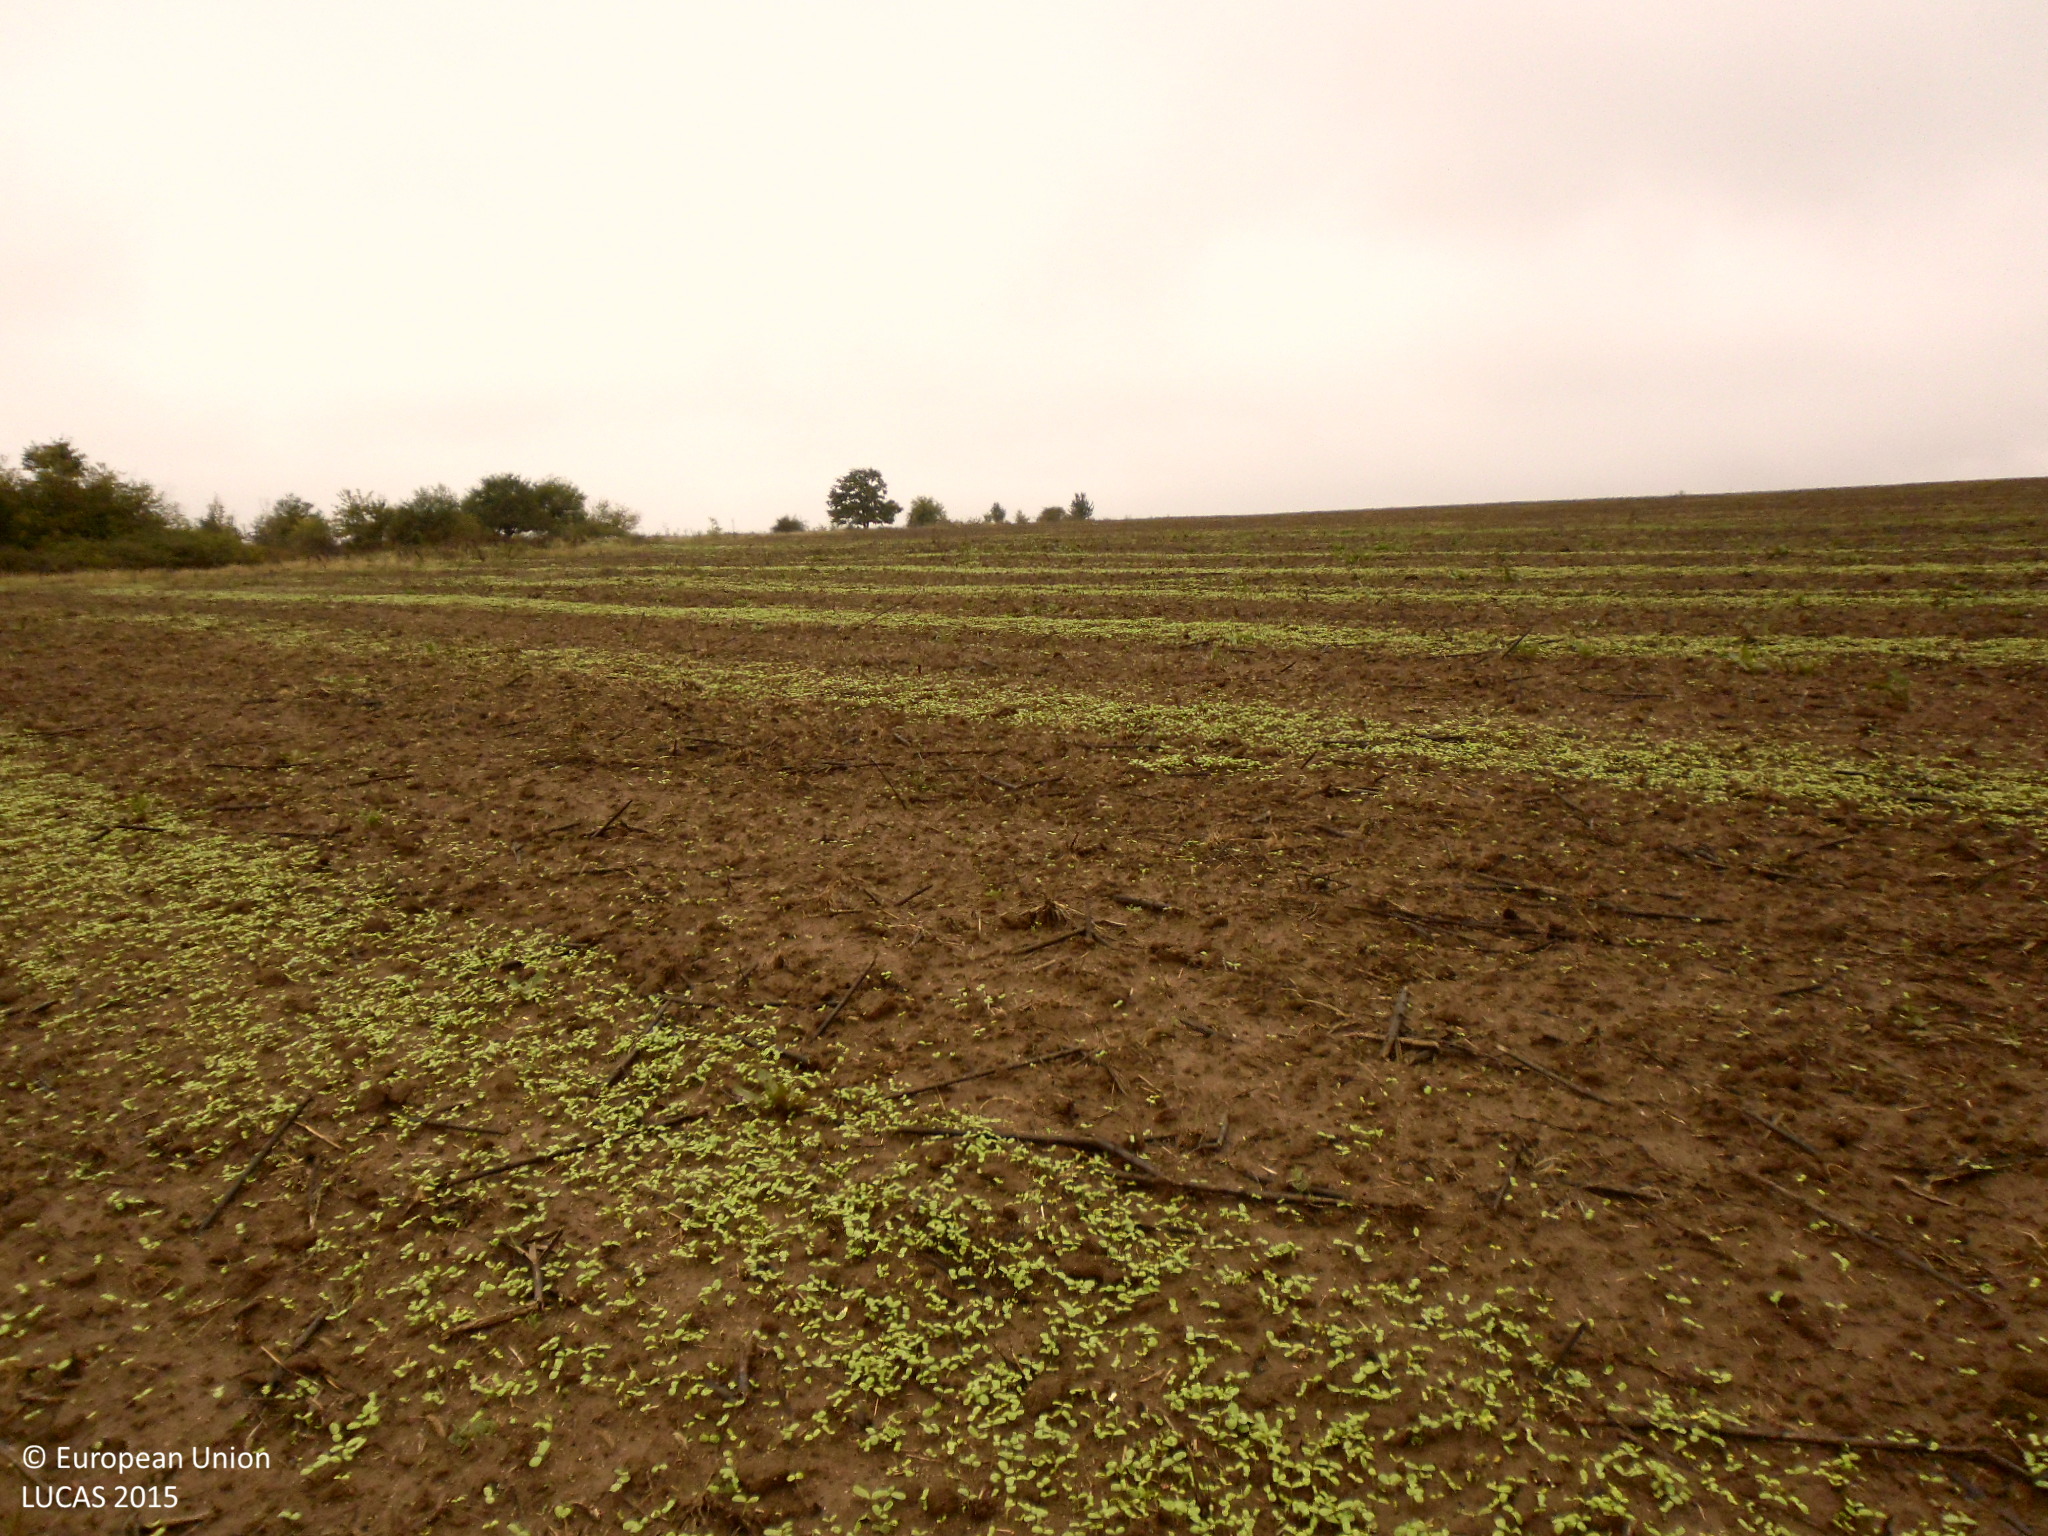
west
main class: Cropland
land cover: Sunflower
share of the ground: < 10 %
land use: Agriculture (excluding fallow land and kitchen gardens)
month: October
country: BG
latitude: 43.9608
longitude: 22.6105
